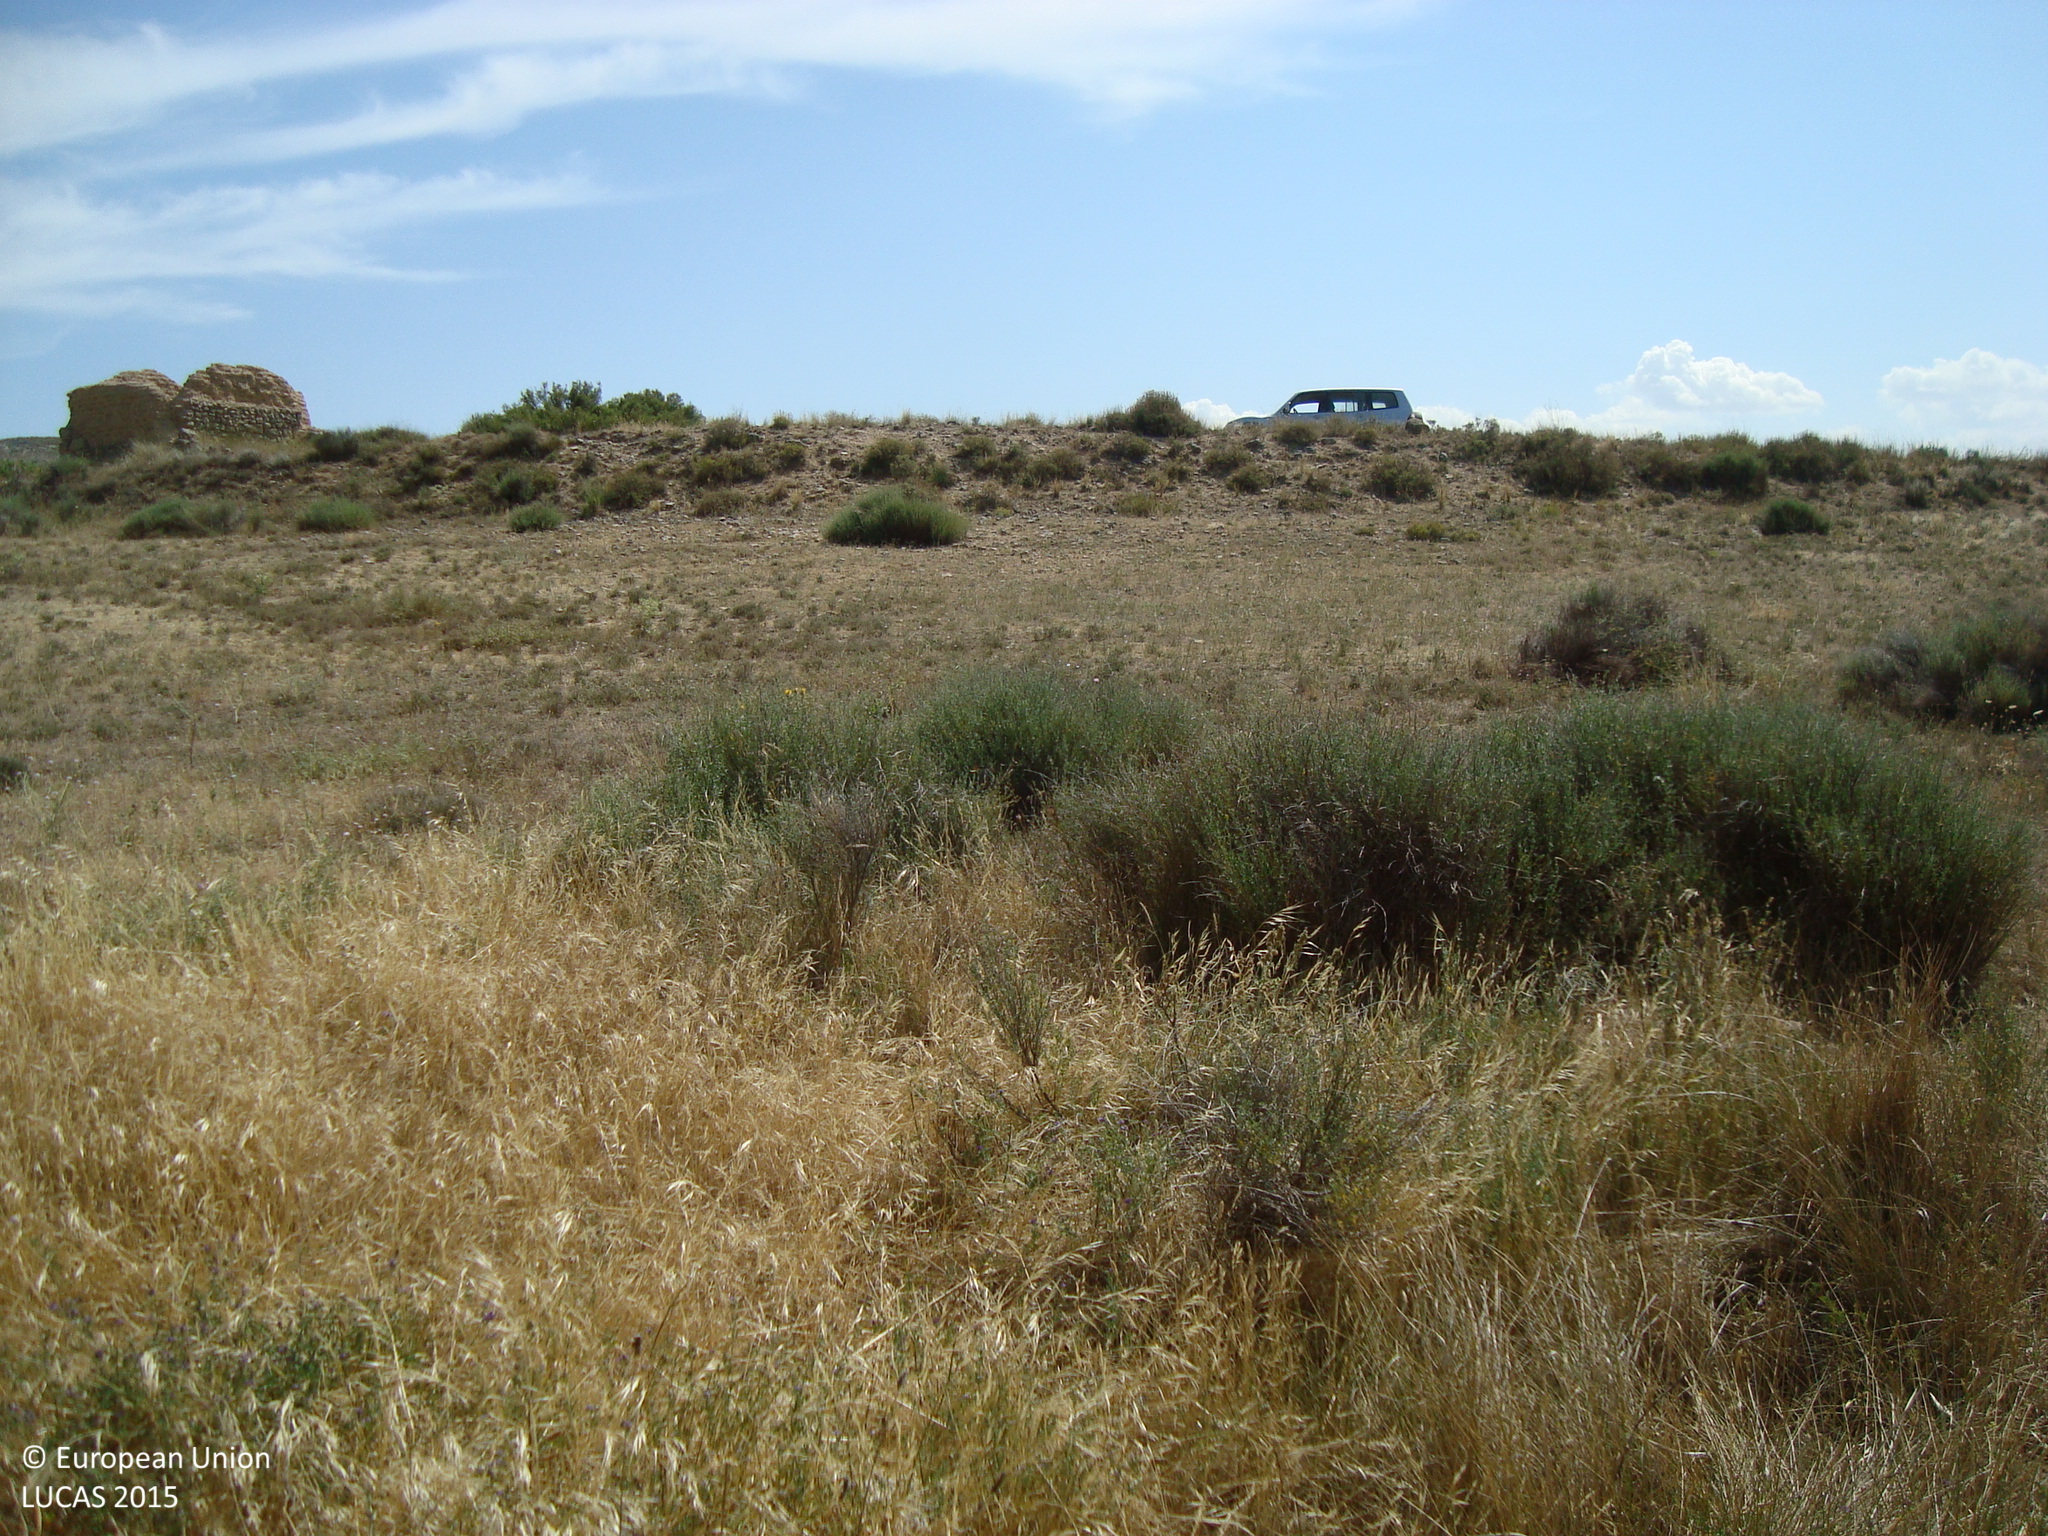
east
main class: Grassland
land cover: Grassland with sparse tree/shrub cover
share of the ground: > 75 %
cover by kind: herbaceous plants 50 %, unconsolidated bare surface 35 %, shrubs 10 %, broadleaved forest trees 5 %
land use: Abandoned areas
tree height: < 5 m
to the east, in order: Grassland with sparse tree/shrub cover; Other bare soil; Groves; Grassland without tree/shrub cover; Dry stone walls; Tracks; Dry stone walls; Spontaneously vegetated surfaces; Barley; Lucerne
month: July
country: ES
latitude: 41.9534
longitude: -4.2398
